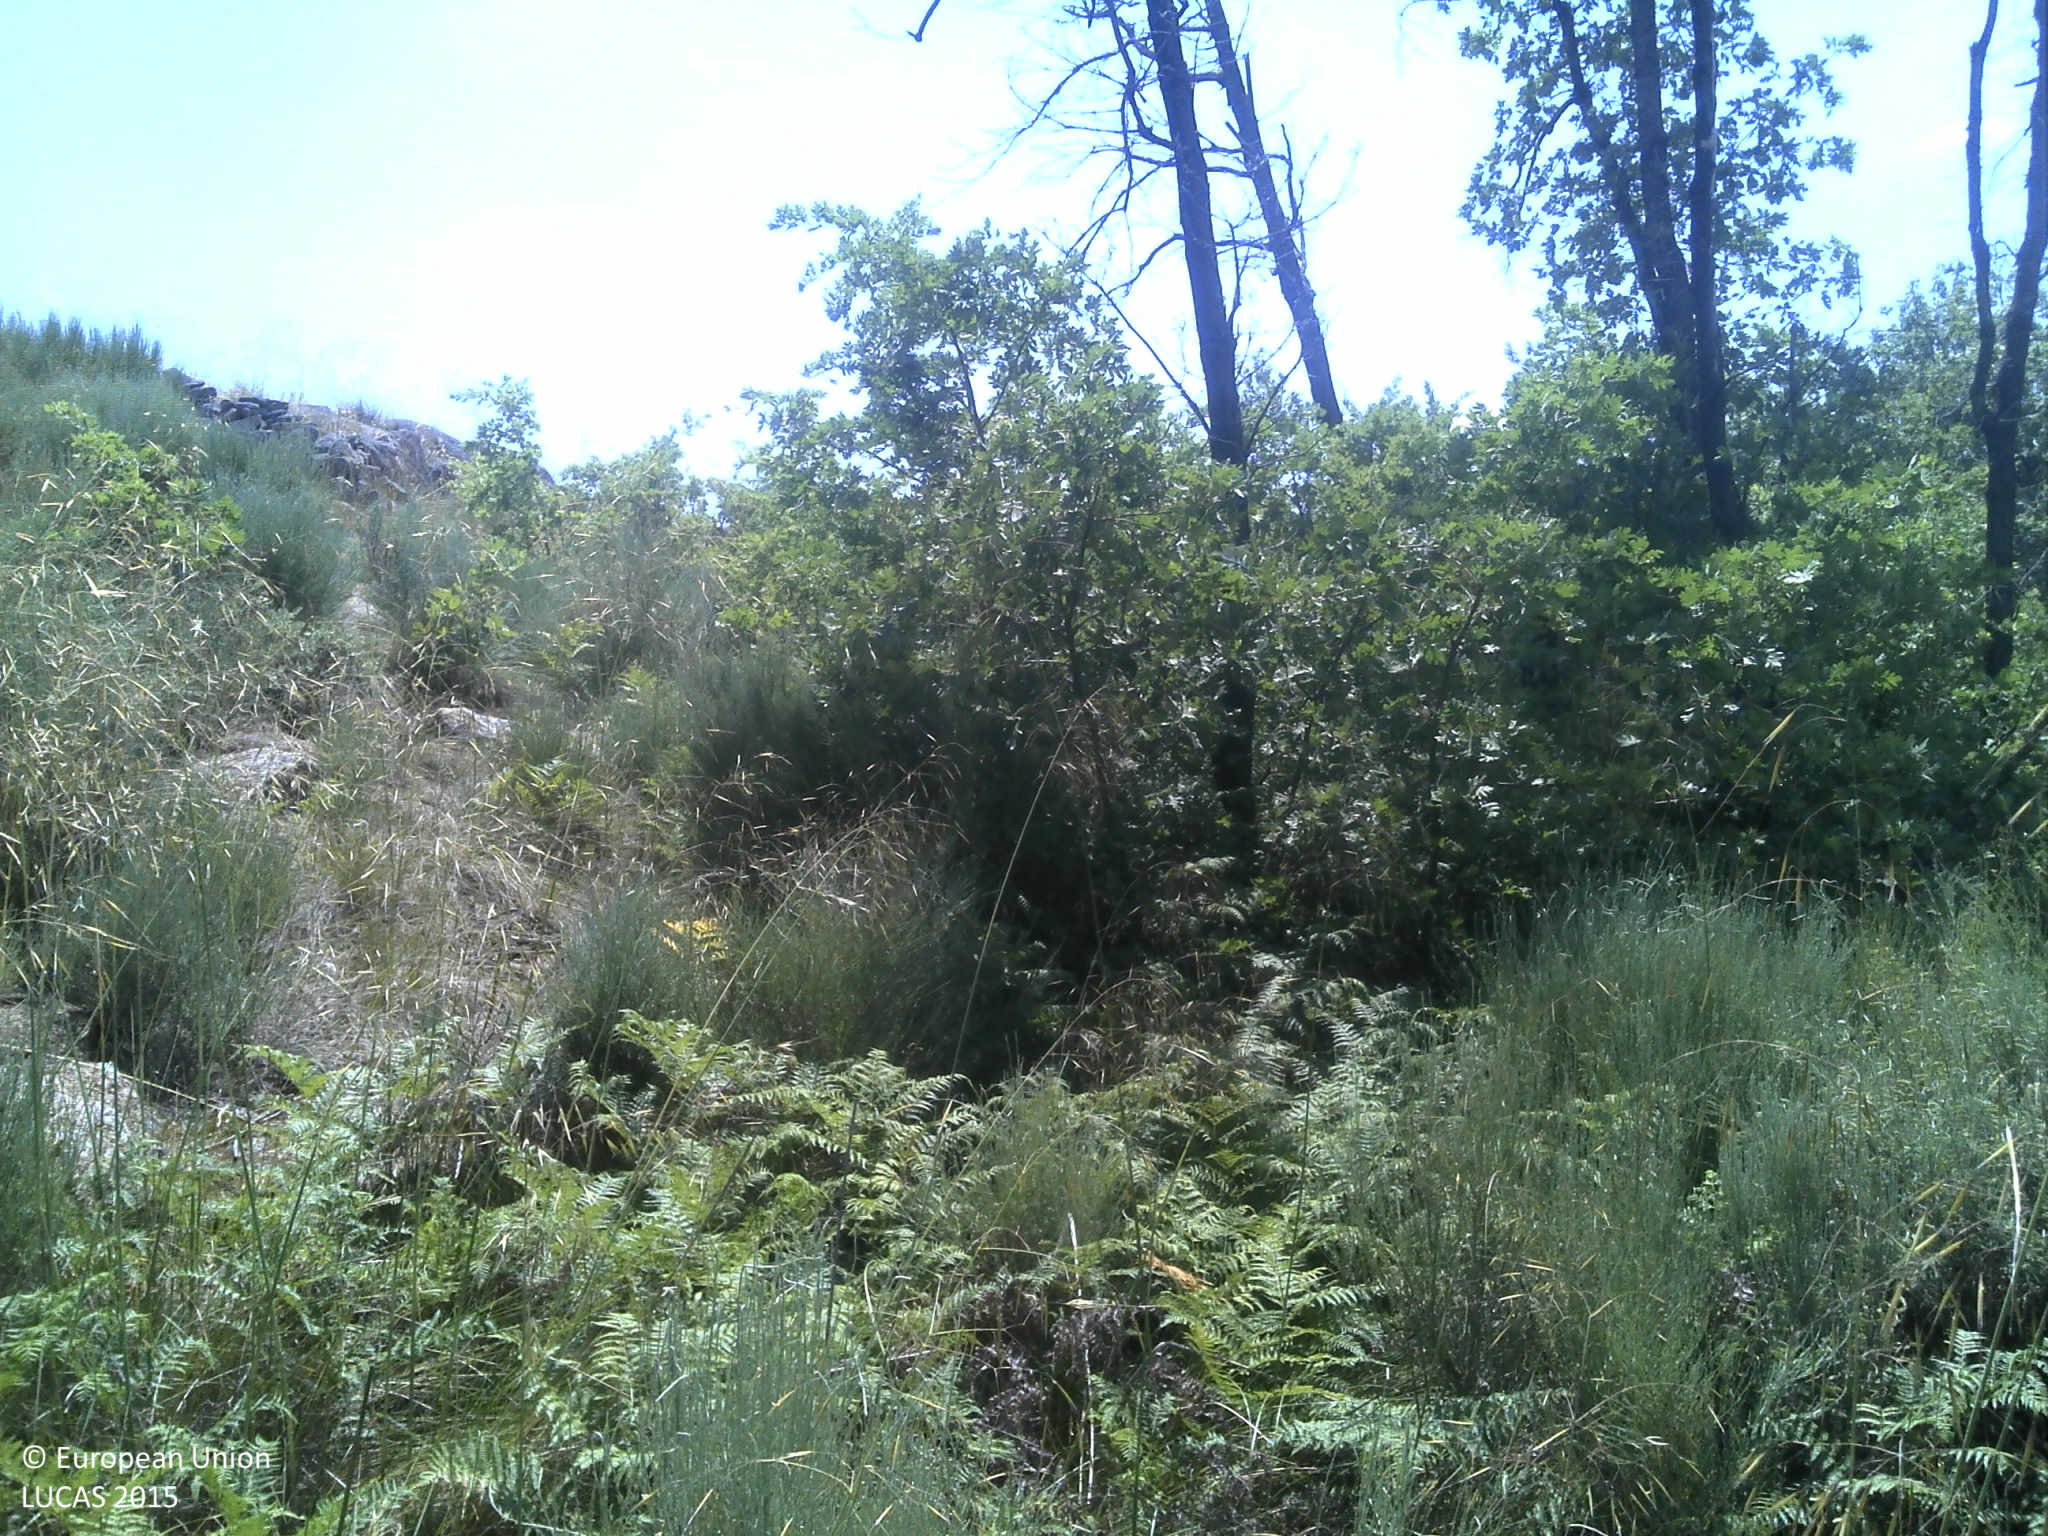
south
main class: Shrubland
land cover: Shrubland with sparse tree cover
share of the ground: 50 - 75 %
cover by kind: shrubs 70 %, herbaceous plants 15 %, unconsolidated bare surface 10 %, broadleaved forest trees 5 %
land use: Semi-natural and natural areas not in use
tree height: < 5 m
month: June
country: PT
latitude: 40.5245
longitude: -6.9906
